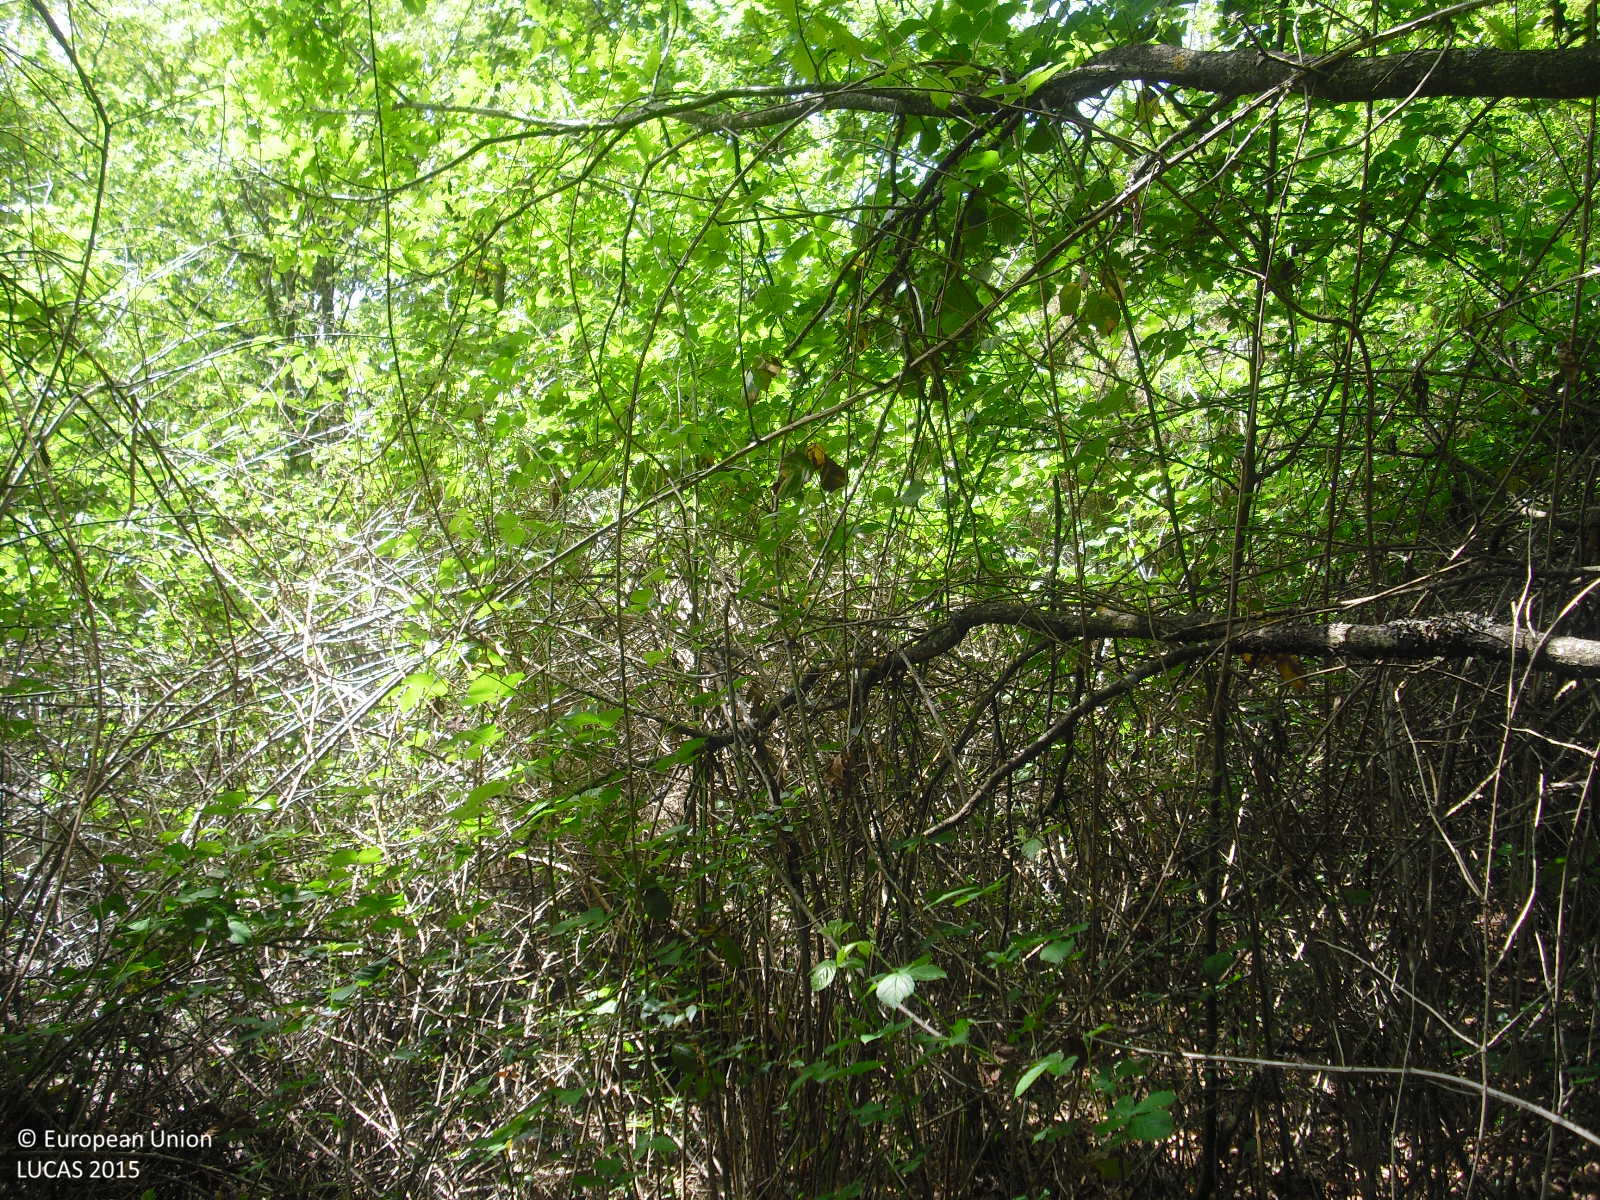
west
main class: Woodland
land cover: Broadleaved woodland
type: acidophilous oak and oak-birch forest
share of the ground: > 75 %
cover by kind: broadleaved forest trees 80 %, shrubs 20 %
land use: Abandoned areas
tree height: > 5 m
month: May
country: ES
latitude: 42.0938
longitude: -7.8090
